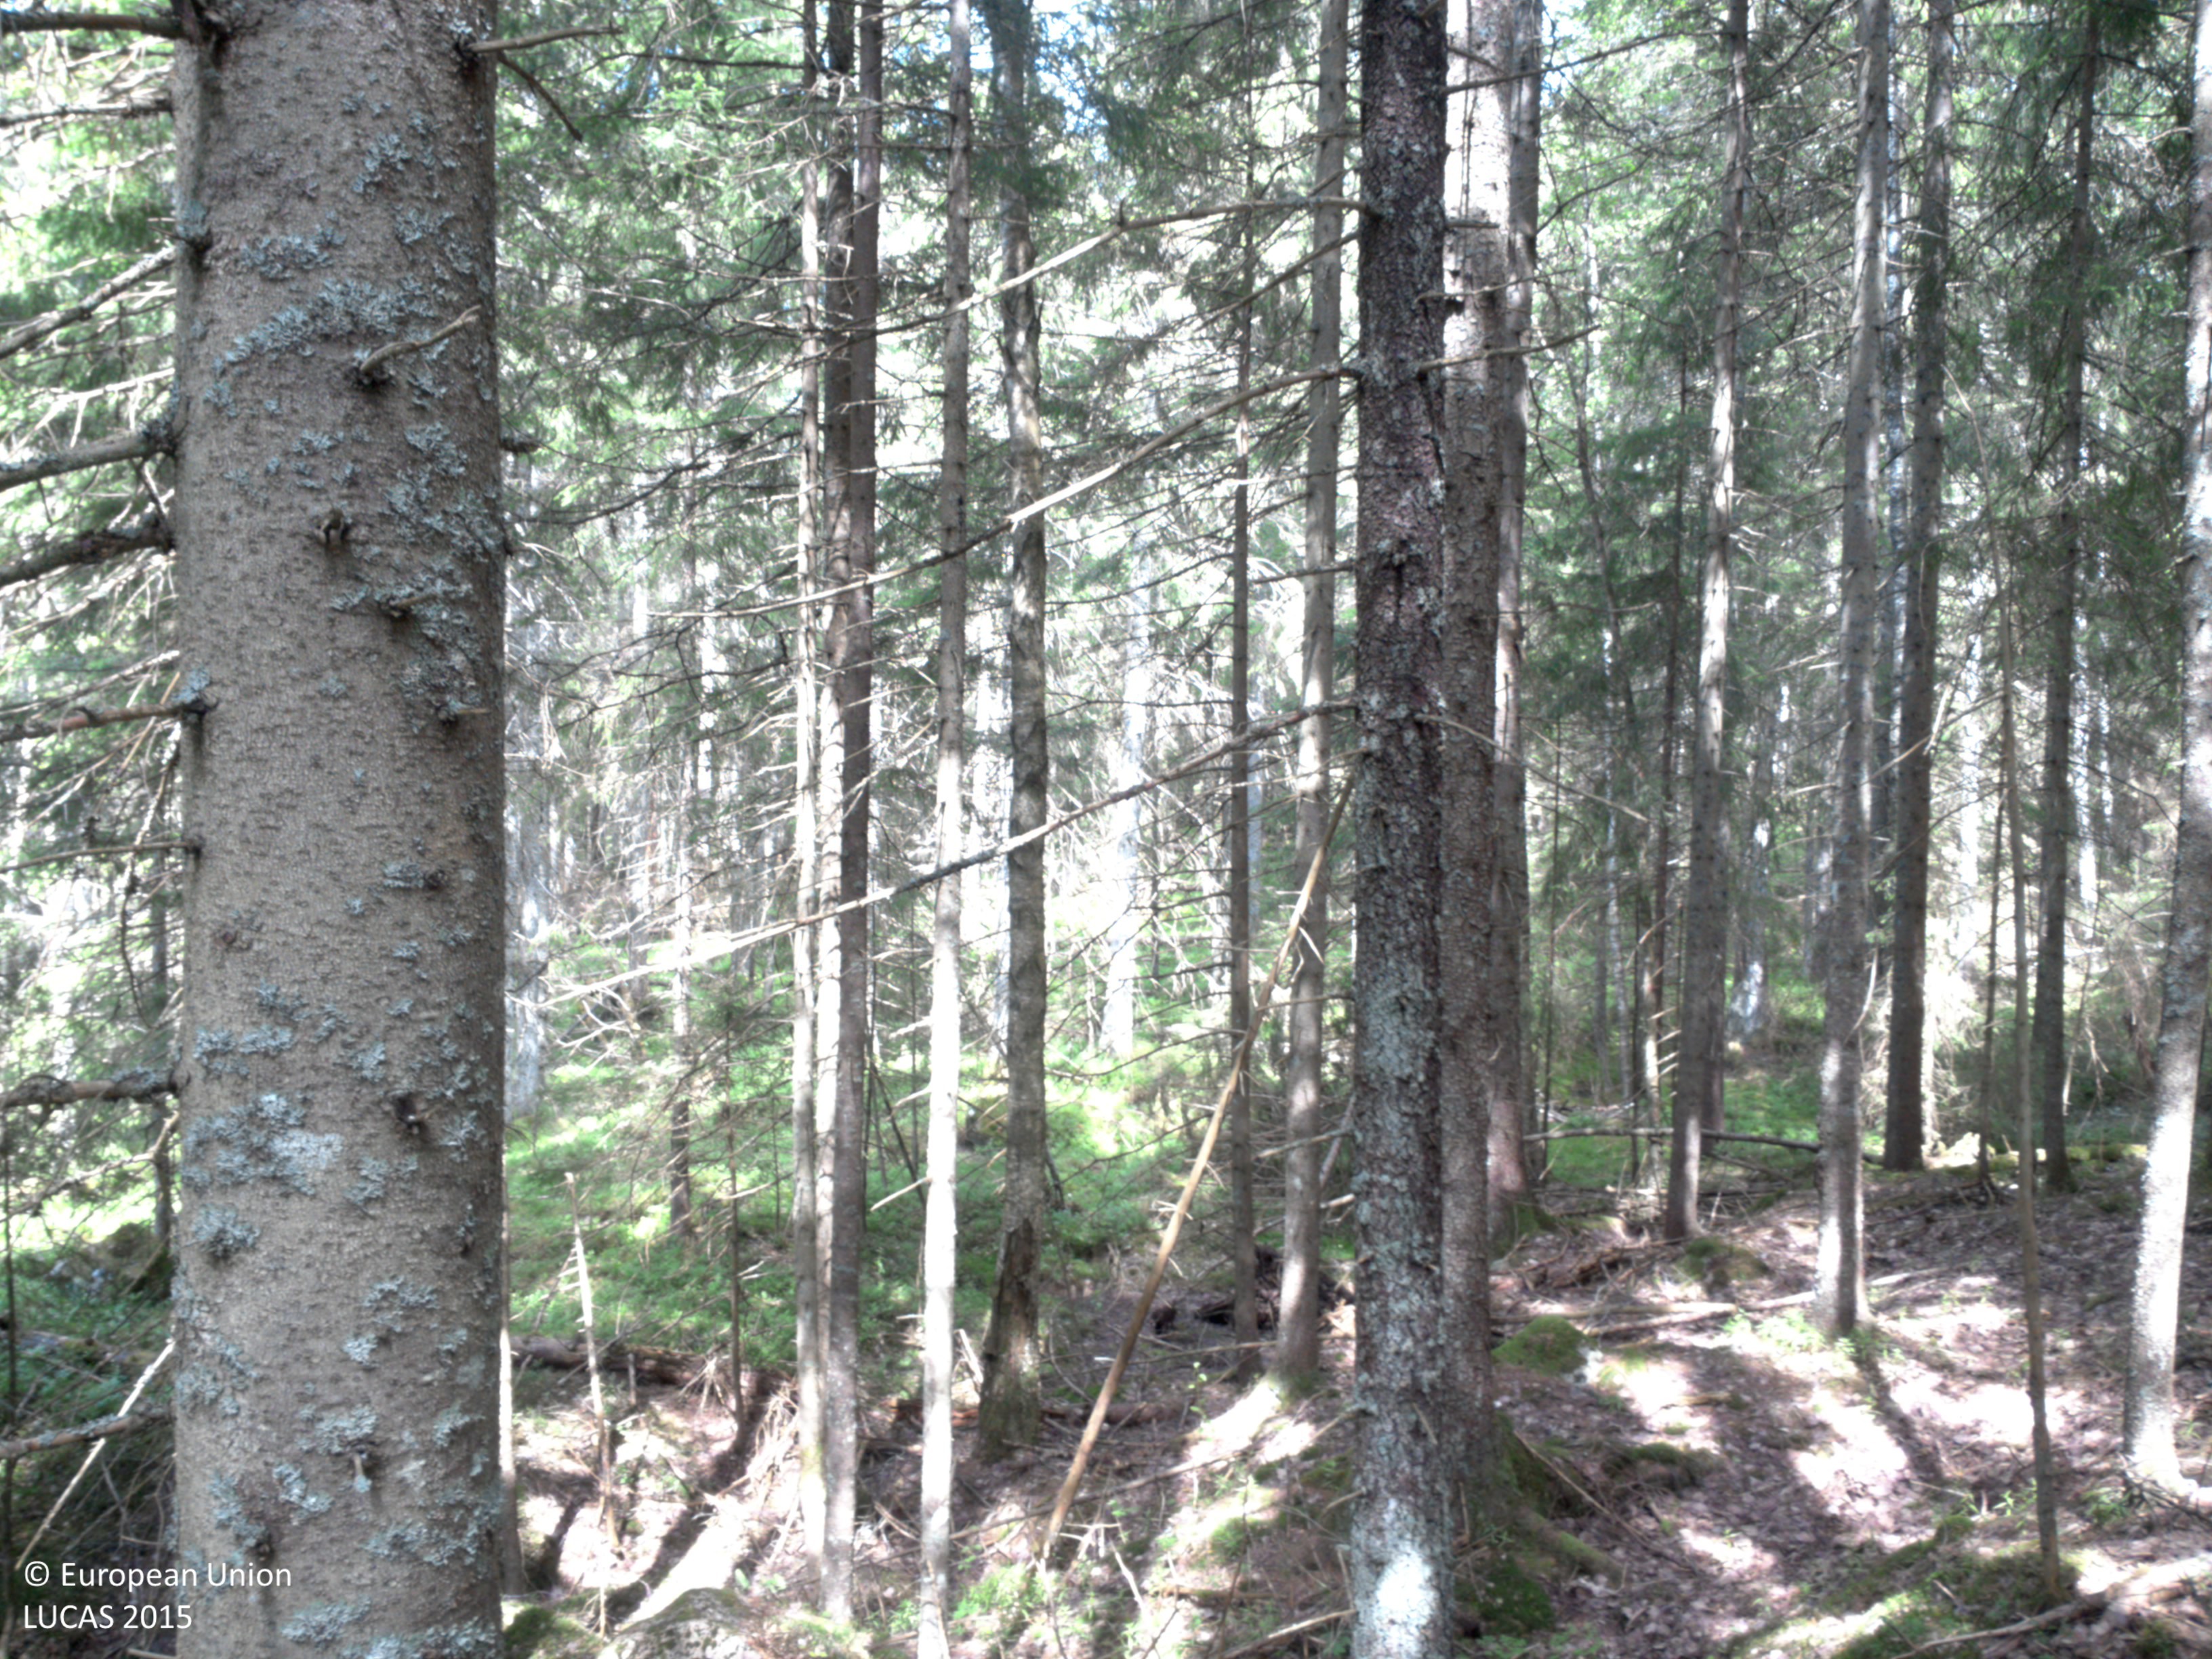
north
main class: Woodland
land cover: Spruce dominated coniferous woodland
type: boreal forest
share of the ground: 50 - 75 %
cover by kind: coniferous forest trees 65 %, lichens and mosses 20 %, shrubs 15 %
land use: Forestry
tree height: > 5 m
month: July
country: SE
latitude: 58.7991
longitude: 11.9513
